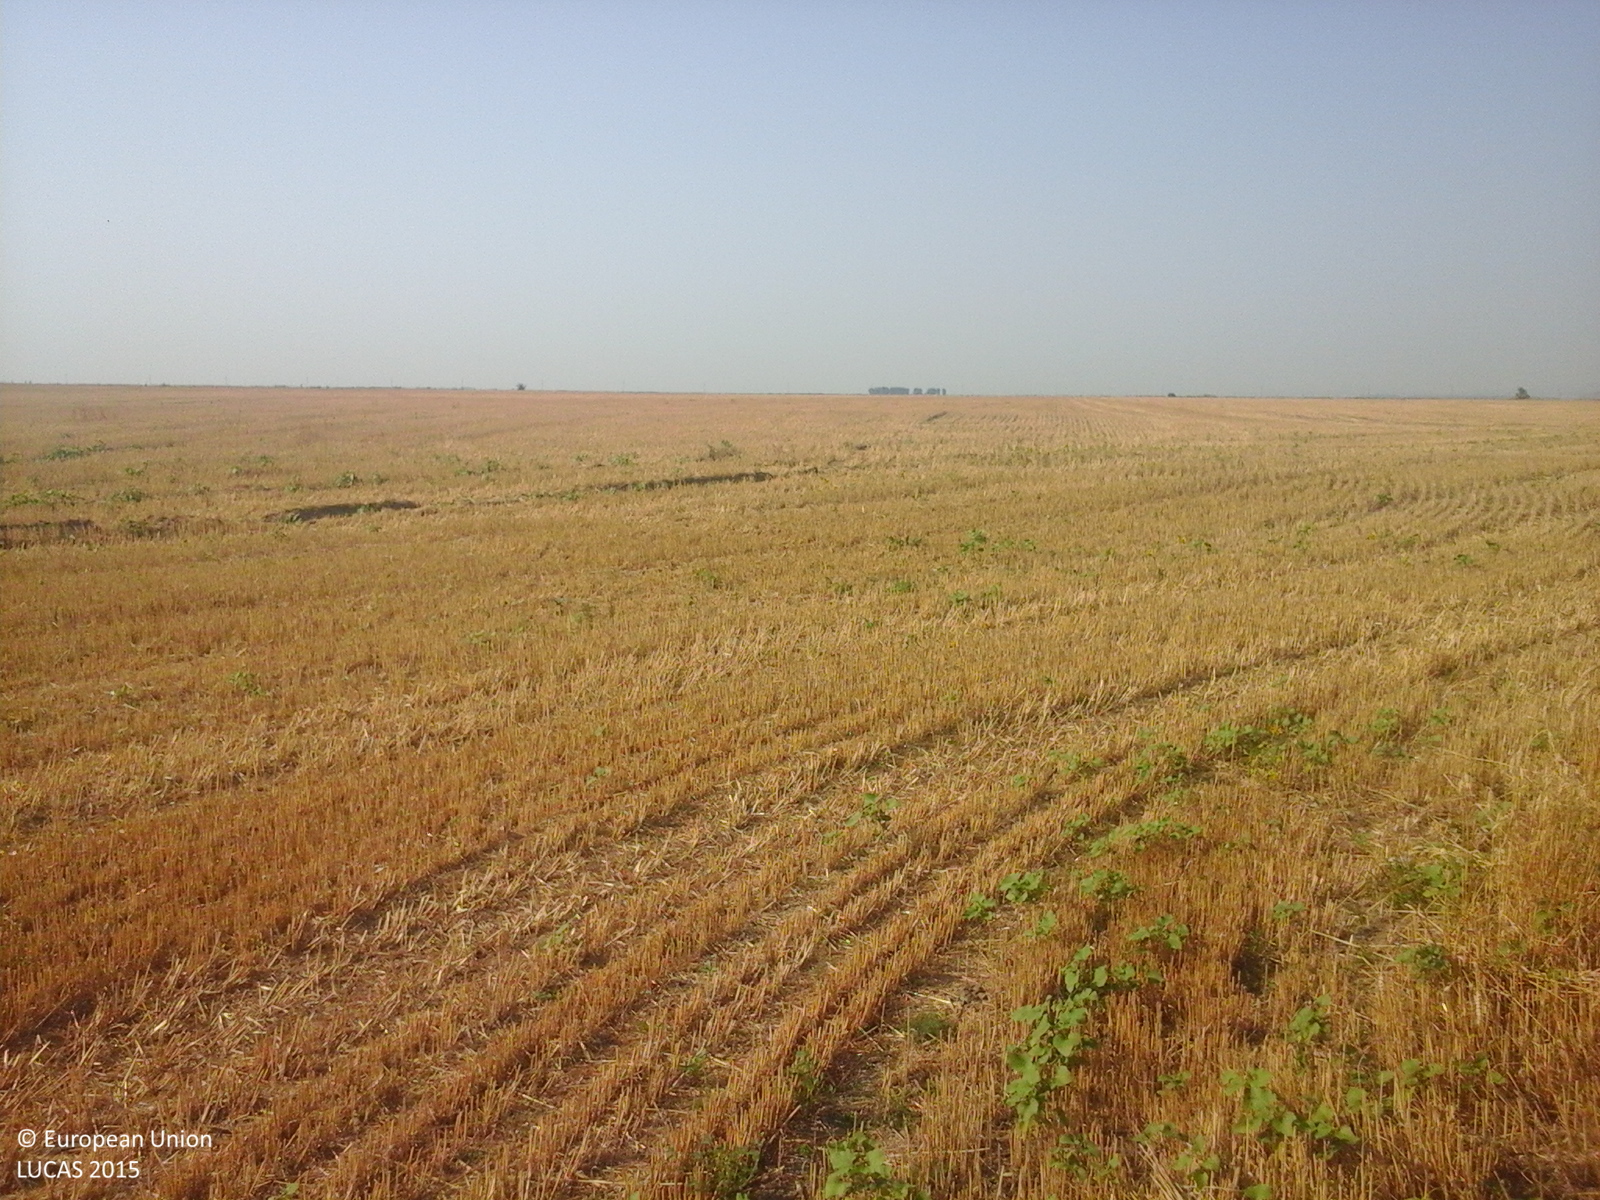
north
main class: Artificial land
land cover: Other artificial areas
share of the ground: > 75 %
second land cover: Durum wheat
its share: 10 - 25 %
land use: Electricity, gas and thermal power distribution
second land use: Agriculture (excluding fallow land and kitchen gardens)
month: August
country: RO
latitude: 44.8860
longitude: 28.0798
